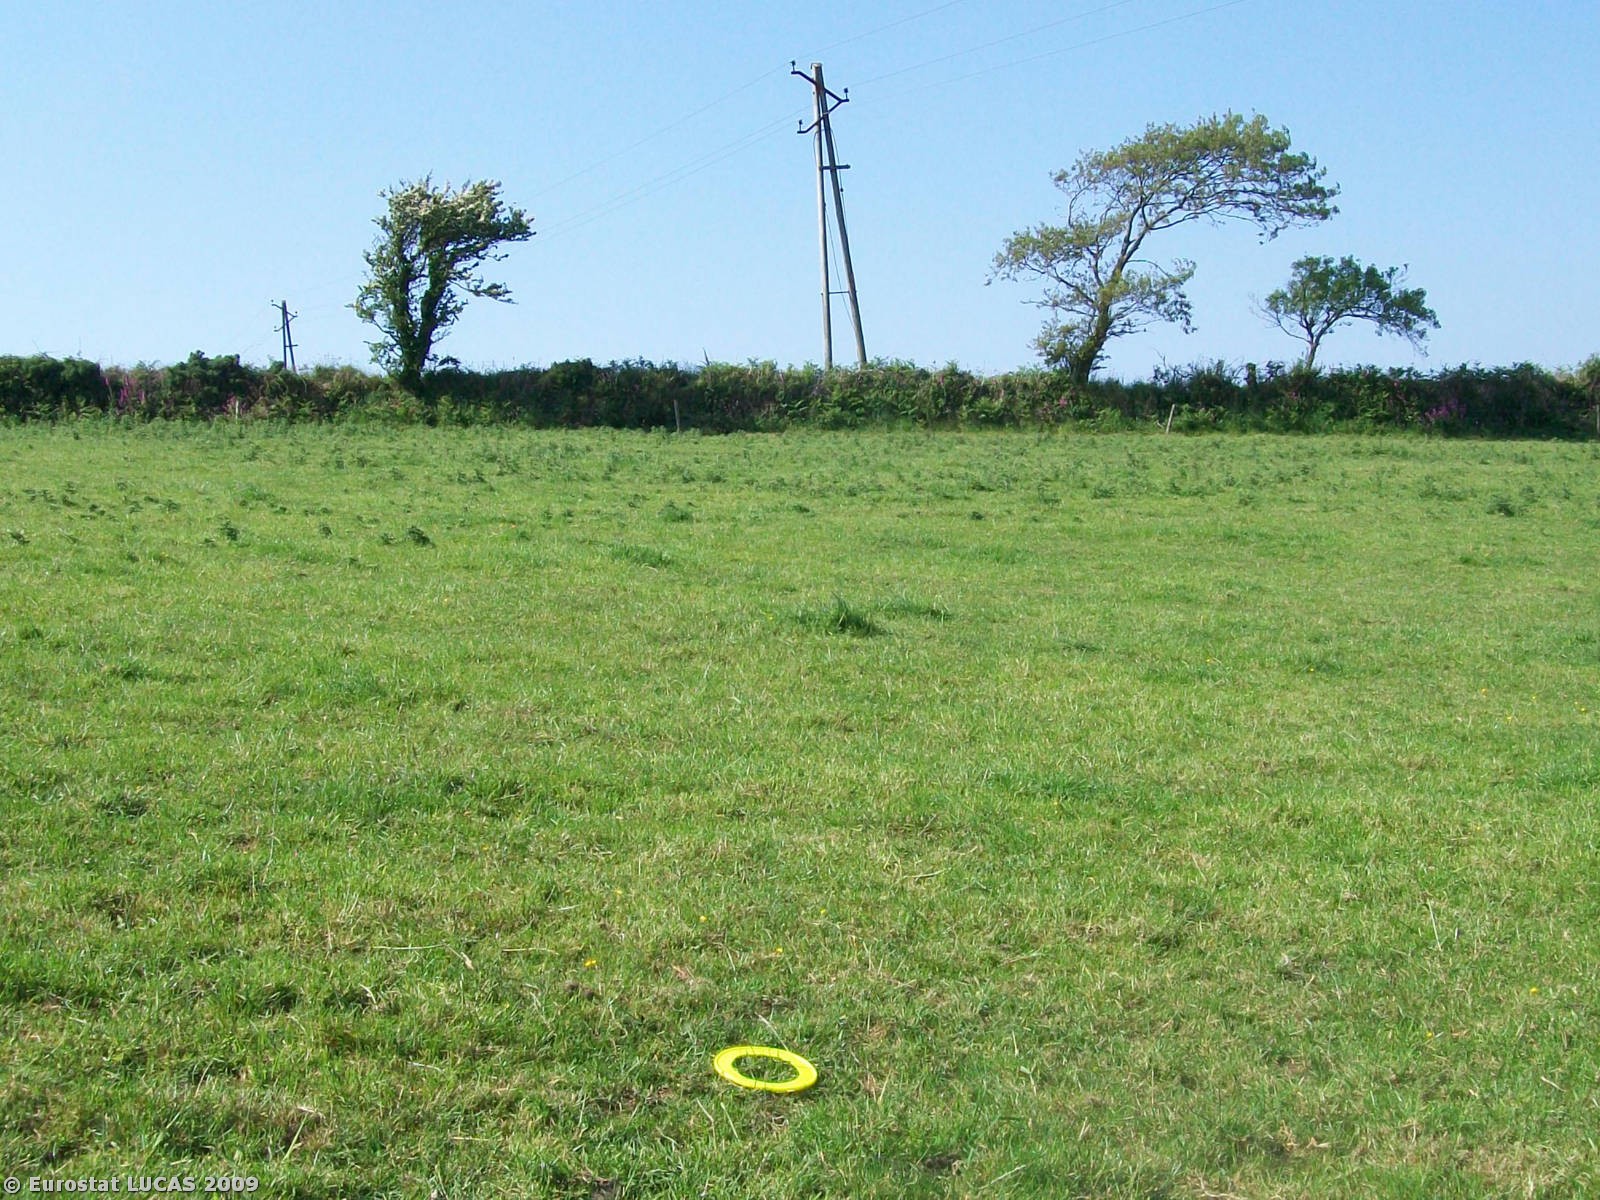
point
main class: Grassland
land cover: Grassland without tree/shrub cover
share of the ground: > 75 %
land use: Agriculture (excluding fallow land and kitchen gardens)
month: June
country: GB
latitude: 50.1579
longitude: -5.1089
